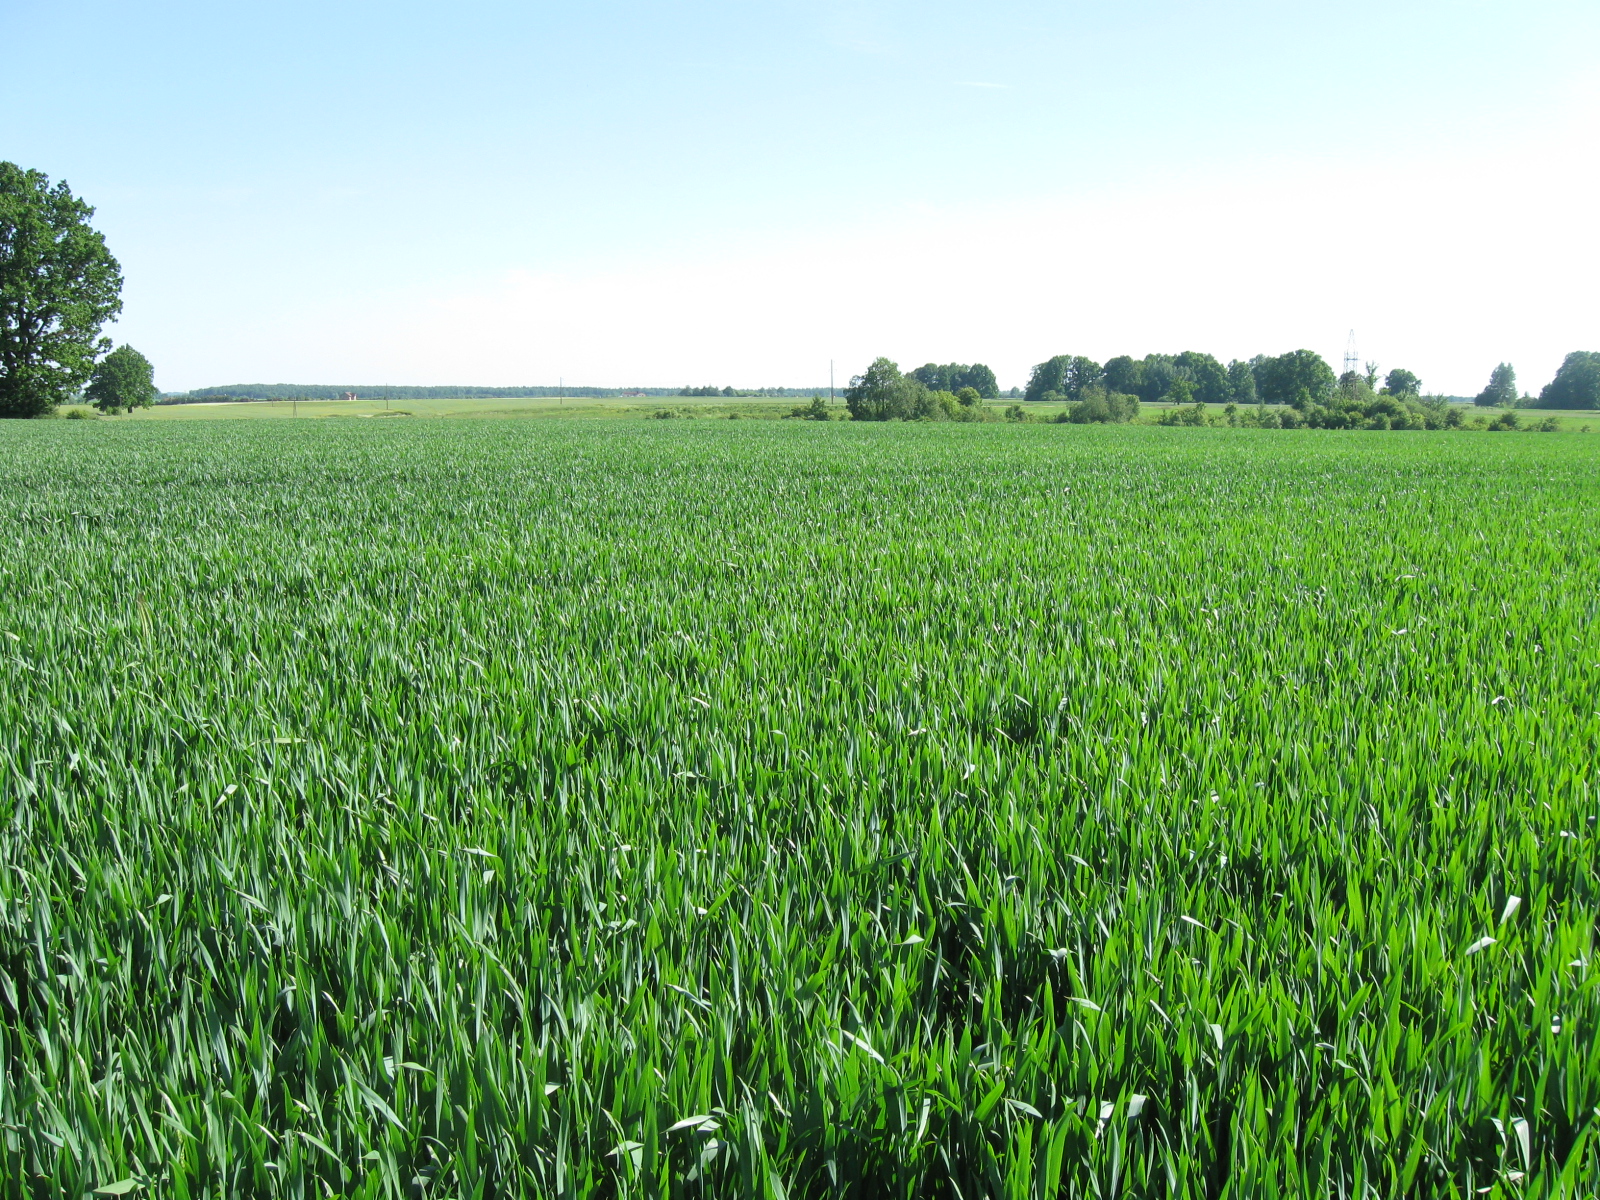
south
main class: Cropland
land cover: Common wheat
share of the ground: > 75 %
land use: Agriculture (excluding fallow land and kitchen gardens)
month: June
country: LT
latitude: 54.8344
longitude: 23.9623
